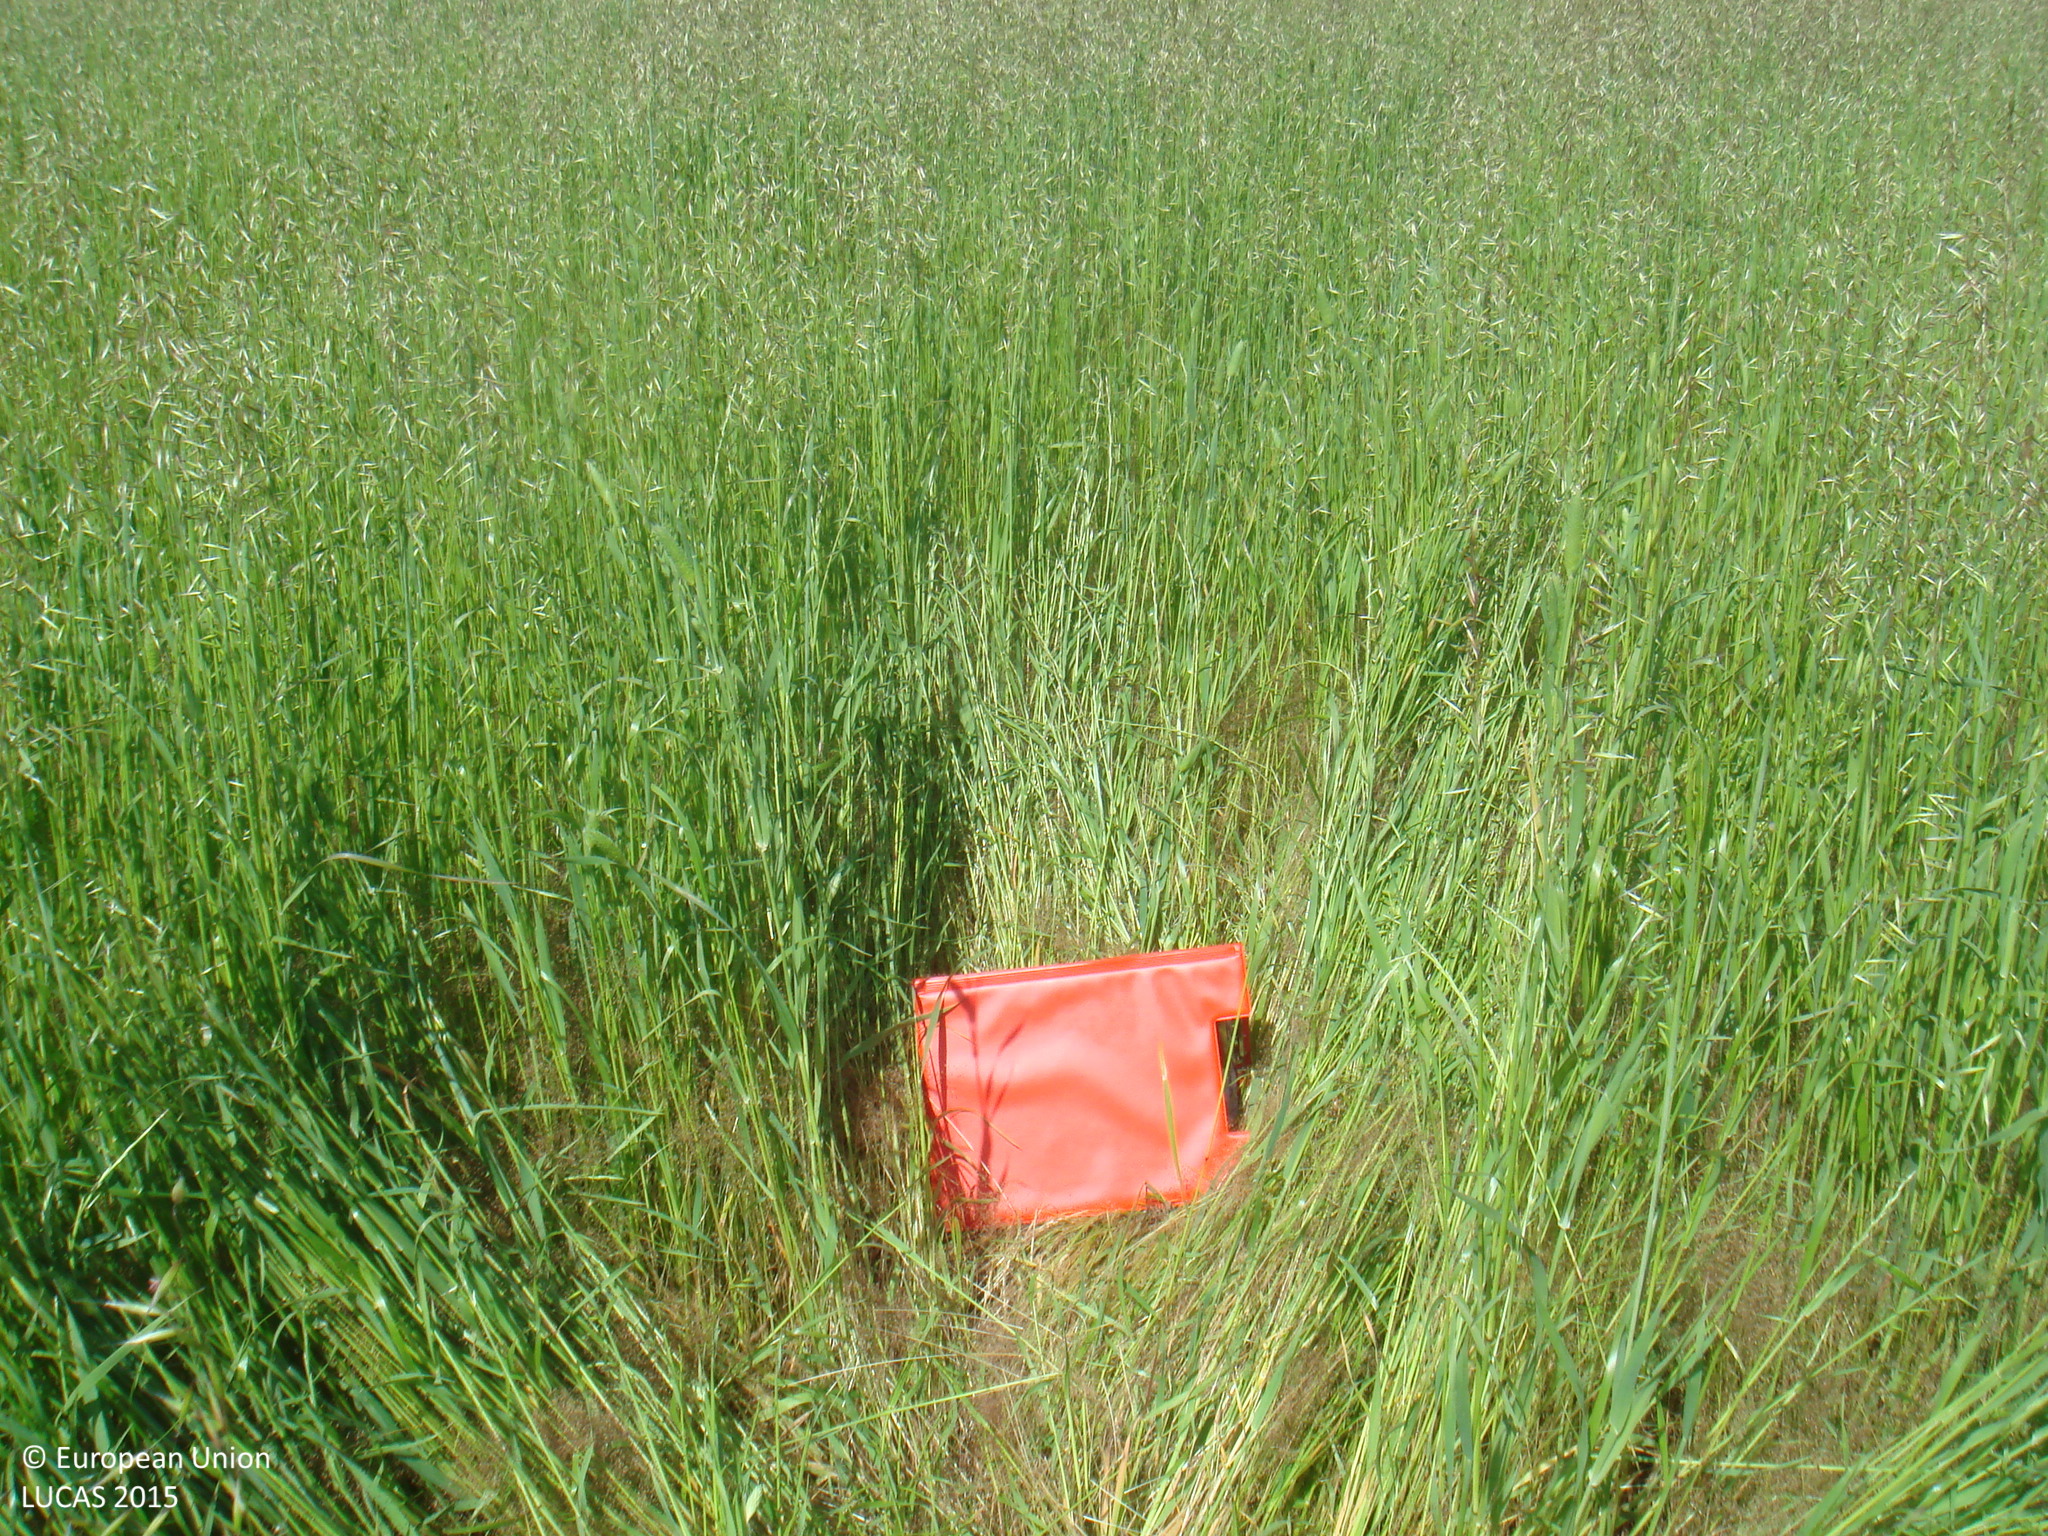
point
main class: Cropland
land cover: Oats
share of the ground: > 75 %
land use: Agriculture (excluding fallow land and kitchen gardens)
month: April
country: ES
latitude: 38.3271
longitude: -5.3934
